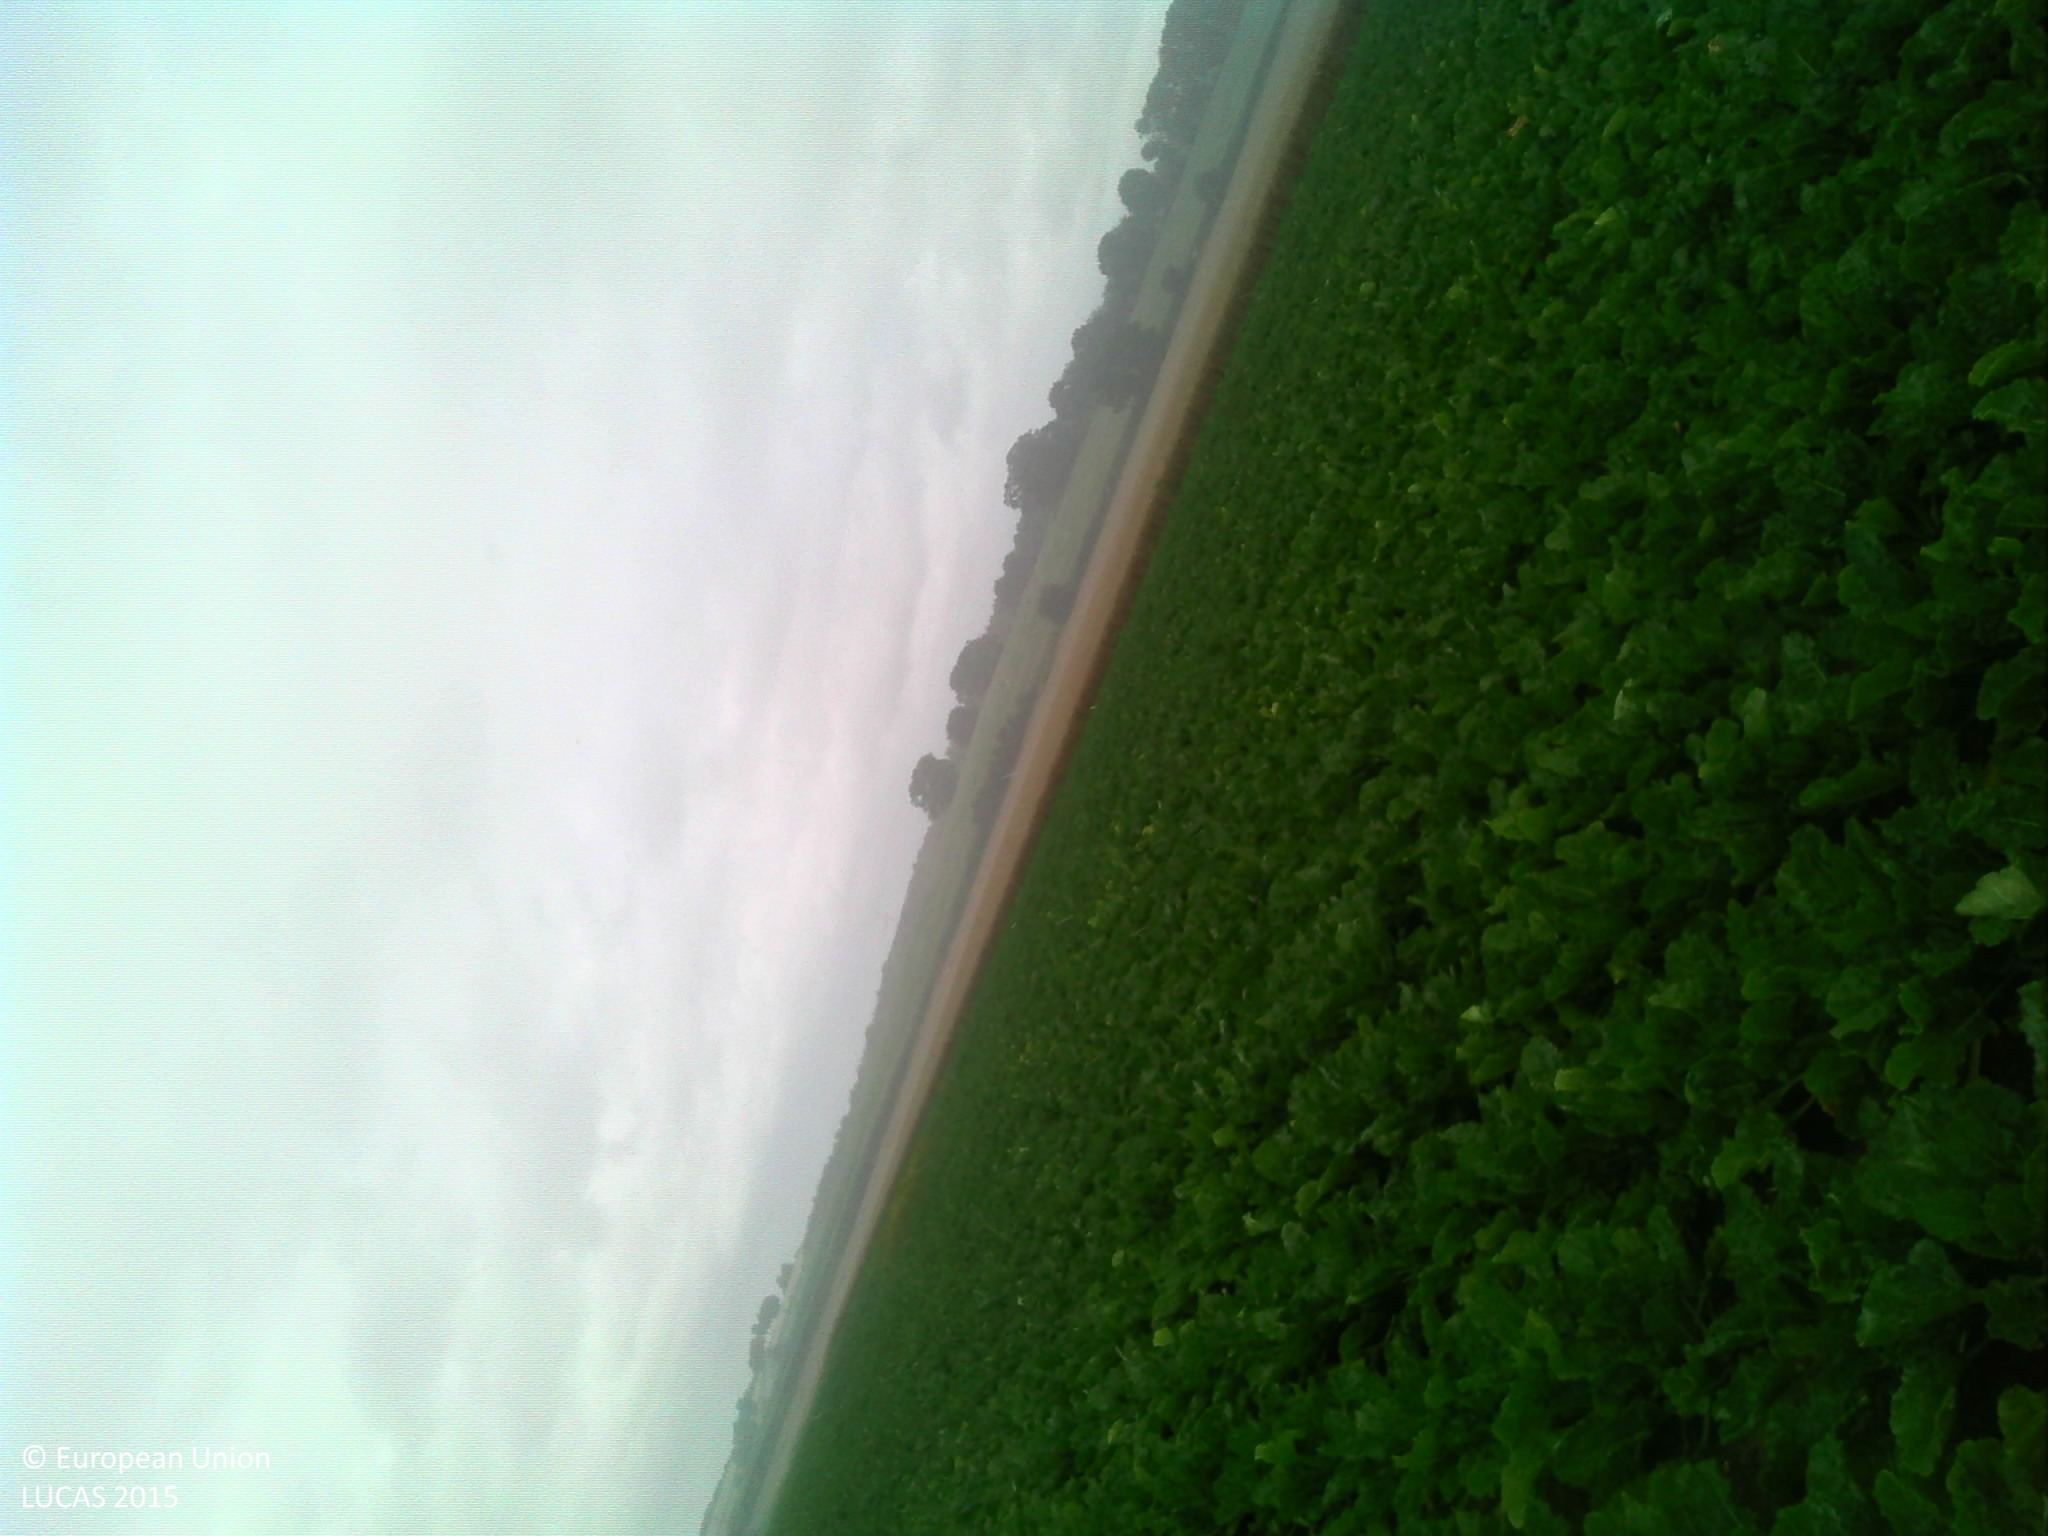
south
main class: Cropland
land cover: Sugar beet
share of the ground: > 75 %
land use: Agriculture (excluding fallow land and kitchen gardens)
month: July
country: FR
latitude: 49.9158
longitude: 3.6285
